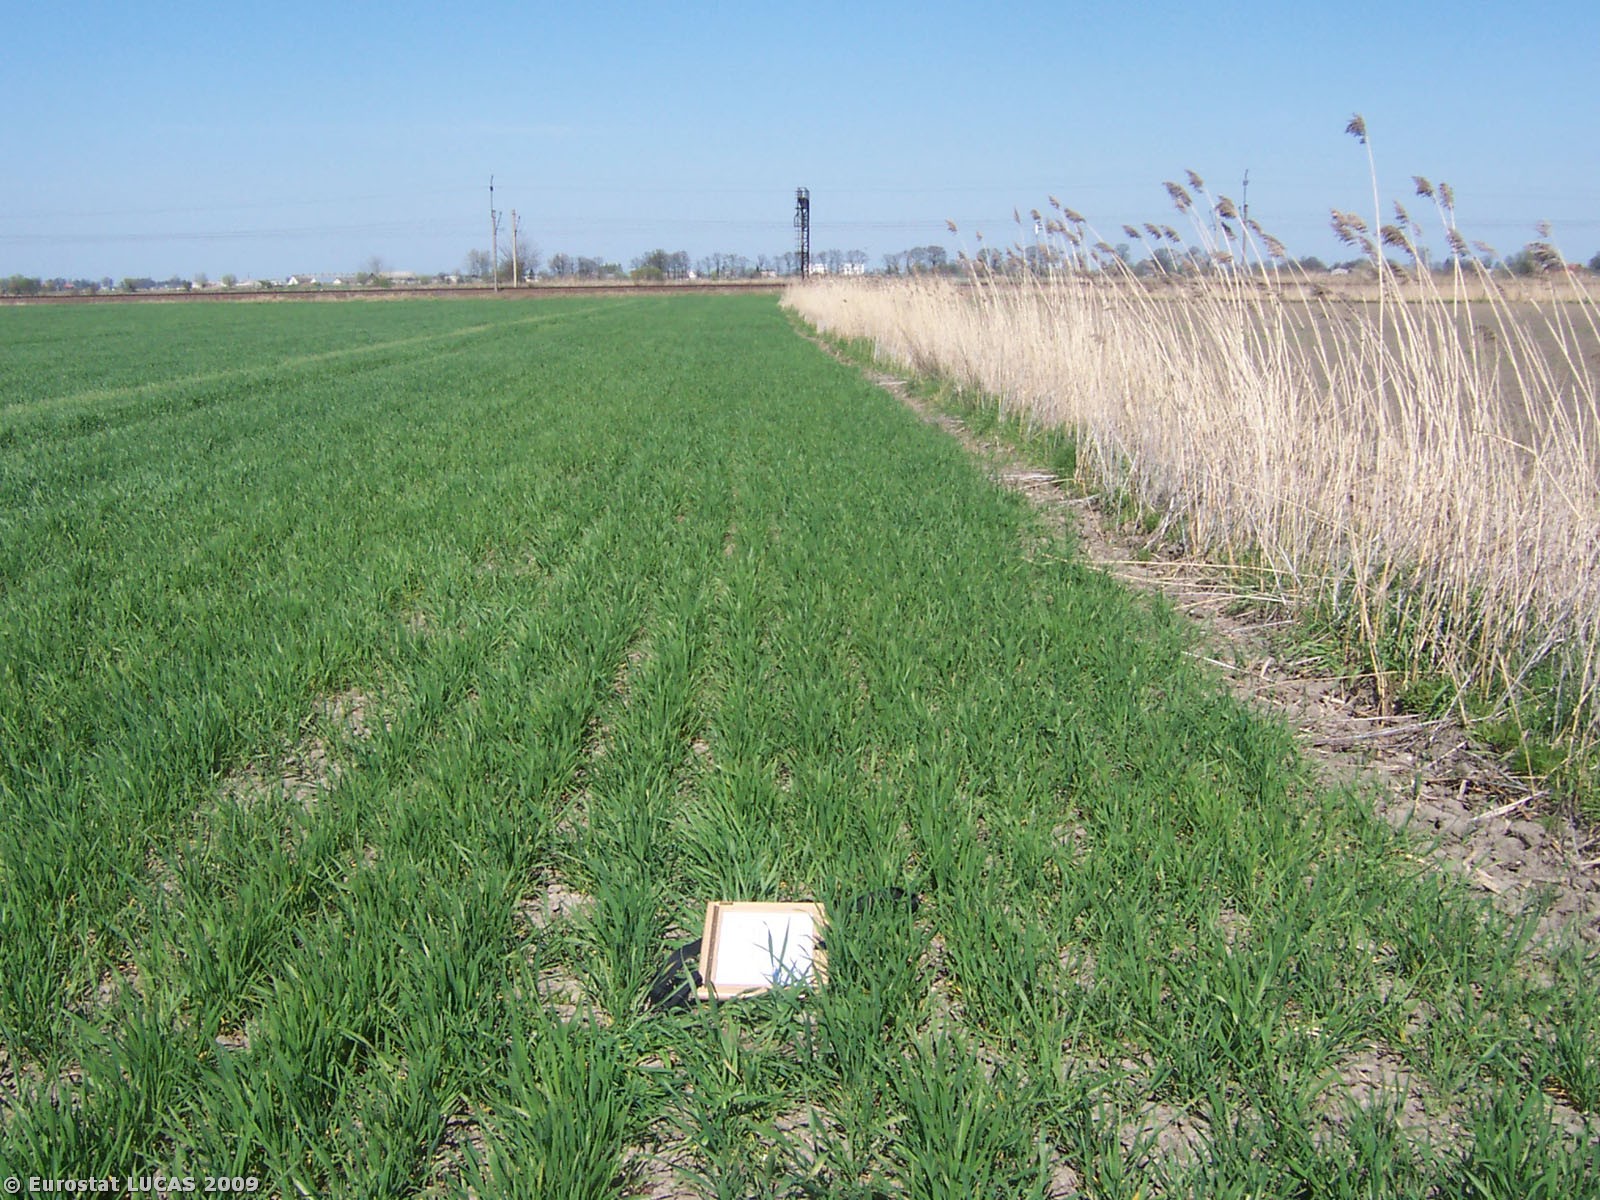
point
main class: Cropland
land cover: Common wheat
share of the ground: 25 - 50 %
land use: Agriculture (excluding fallow land and kitchen gardens)
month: April
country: PL
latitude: 54.0644
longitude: 18.9595
